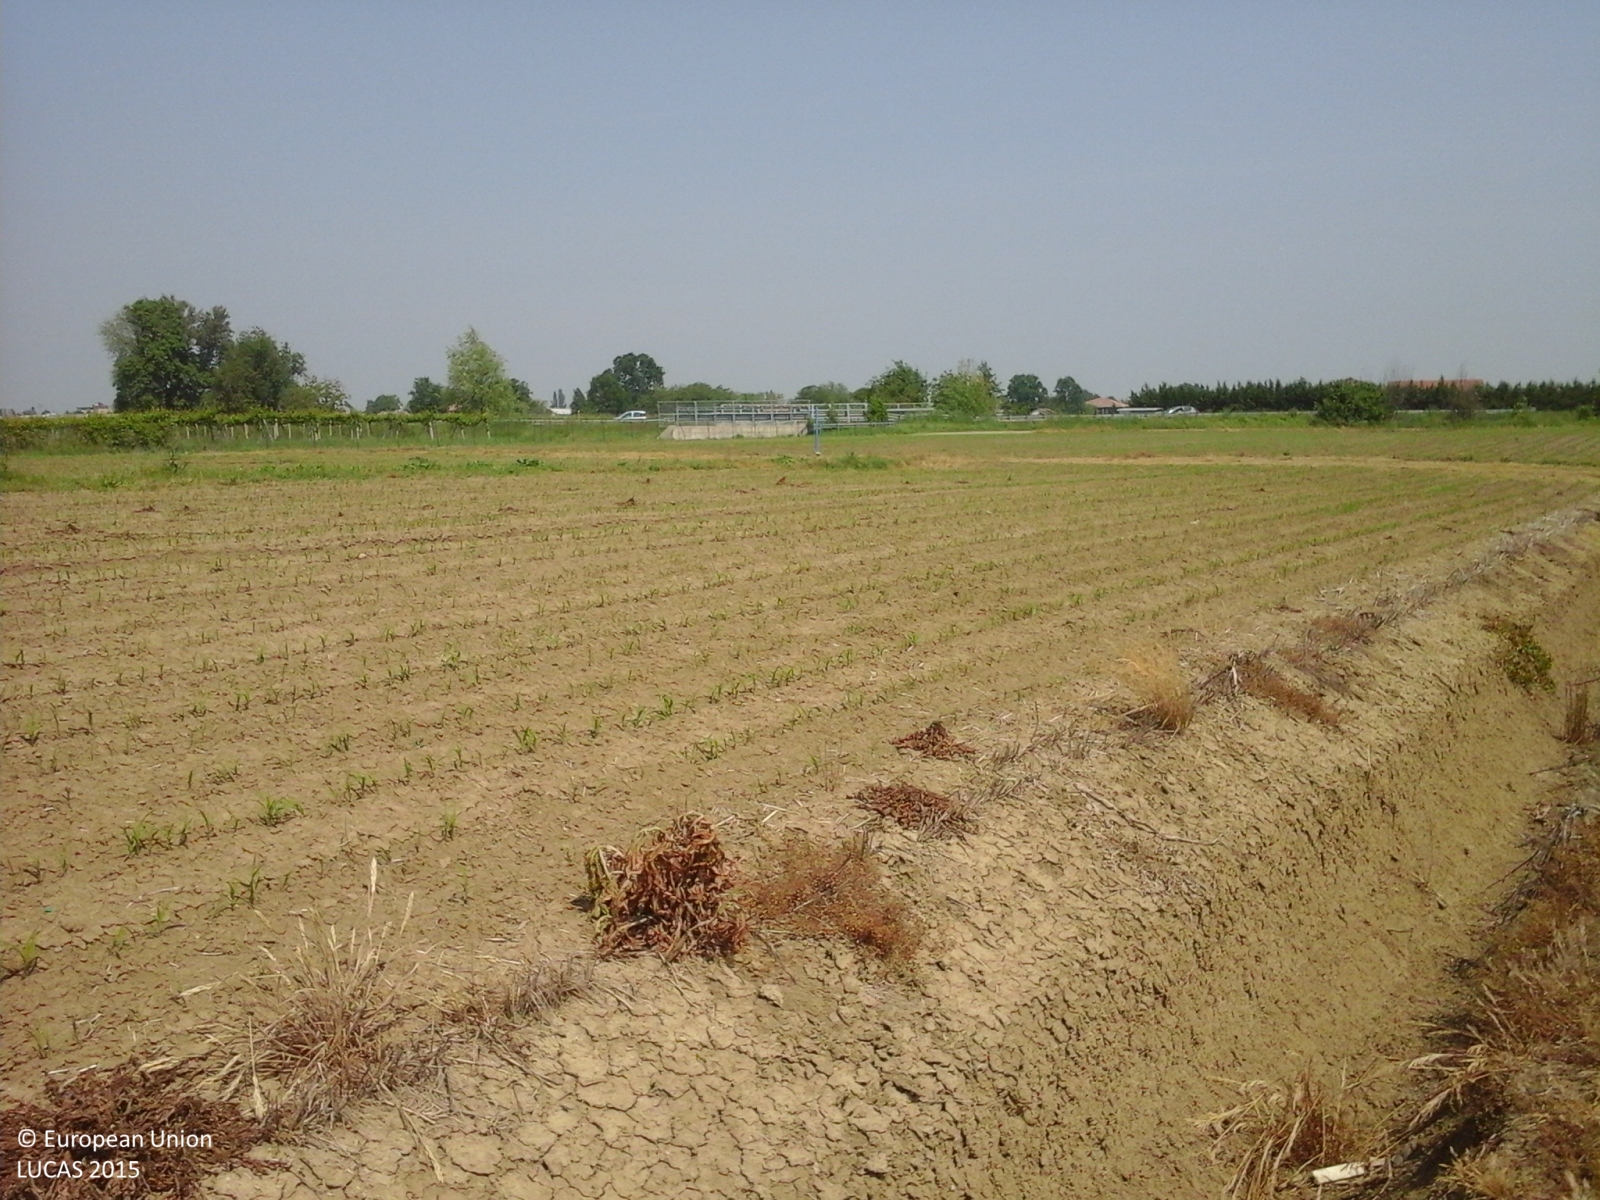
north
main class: Cropland
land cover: Other cereals
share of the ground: < 10 %
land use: Agriculture (excluding fallow land and kitchen gardens)
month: May
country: IT
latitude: 44.5795
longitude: 11.0682
